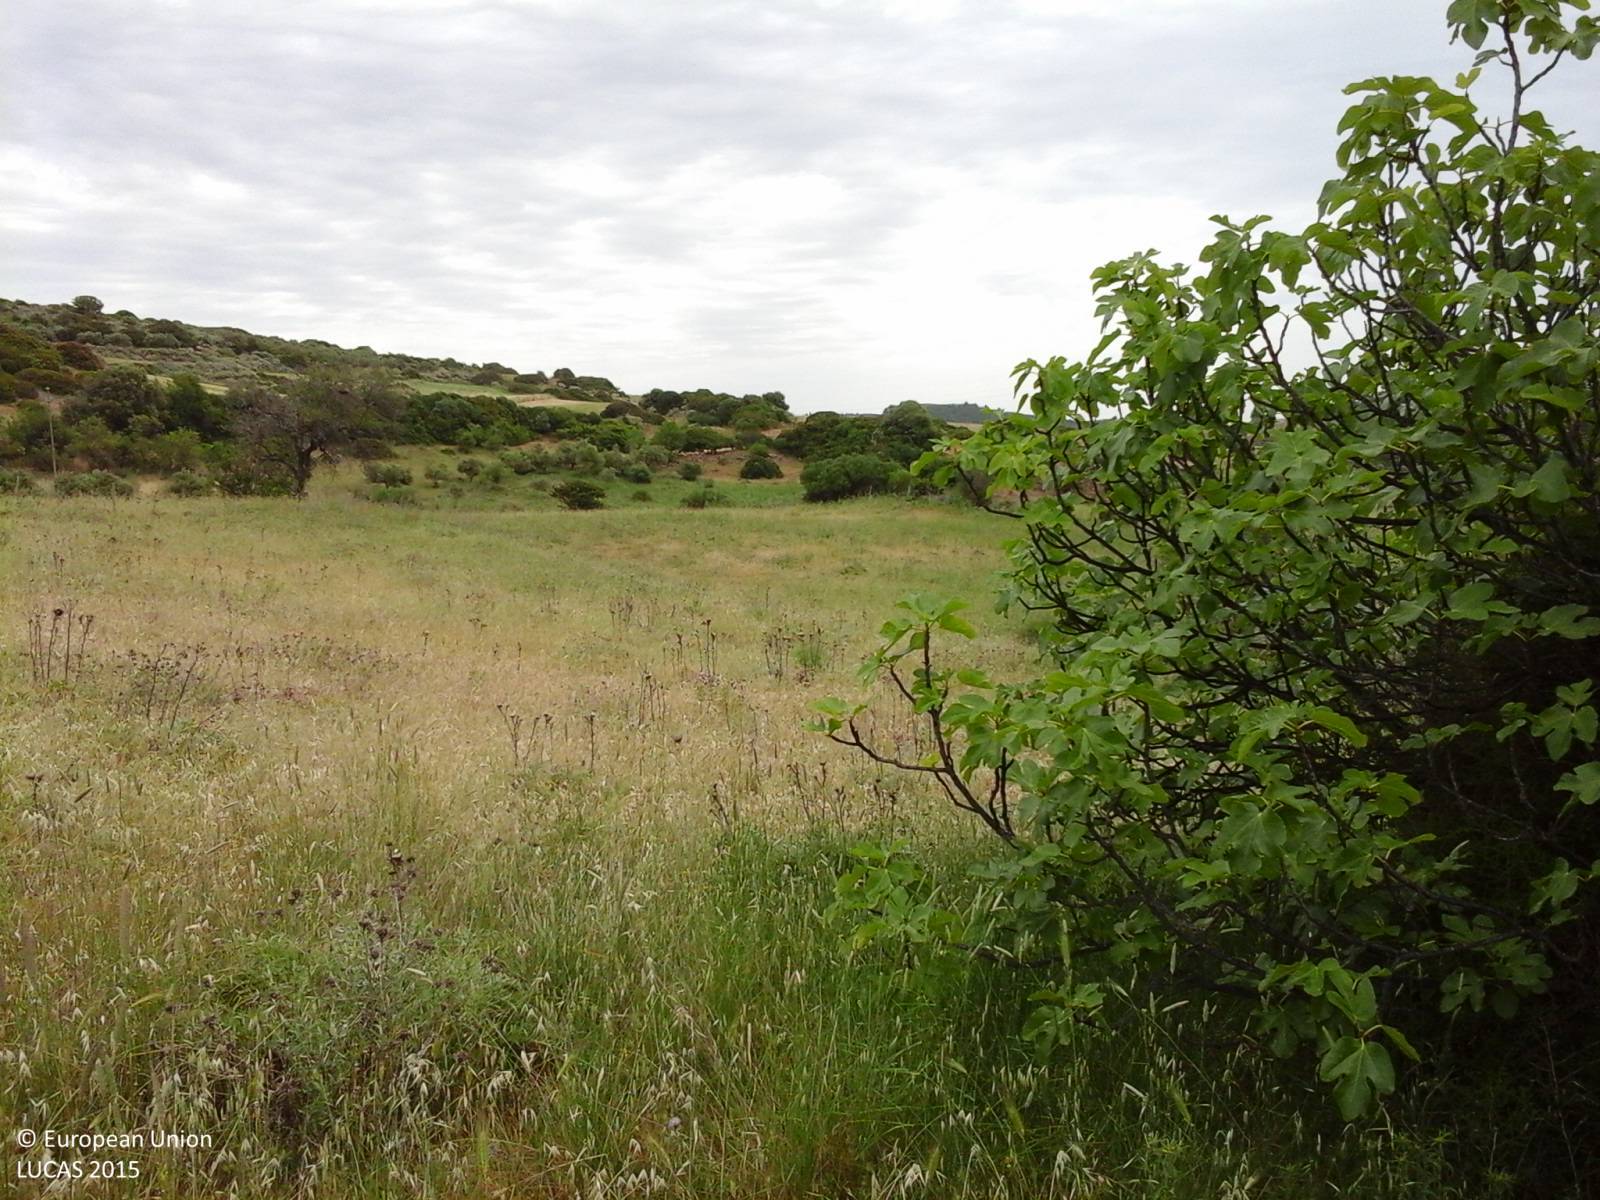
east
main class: Cropland
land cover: Dry pulses
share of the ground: 25 - 50 %
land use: Agriculture (excluding fallow land and kitchen gardens)
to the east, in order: Dry pulses; Abandoned hedges; Fences; Grassland without tree/shrub cover; Ditches and canals; Grass margins; Tracks; Grass margins; Fences; Grassland without tree/shrub cover; Abandoned hedges; Grassland without tree/shrub cover; Electric lines; Grassland without tree/shrub cover; Grassland with sparse tree/shrub cover
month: May
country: IT
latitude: 39.7346
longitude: 8.7818
